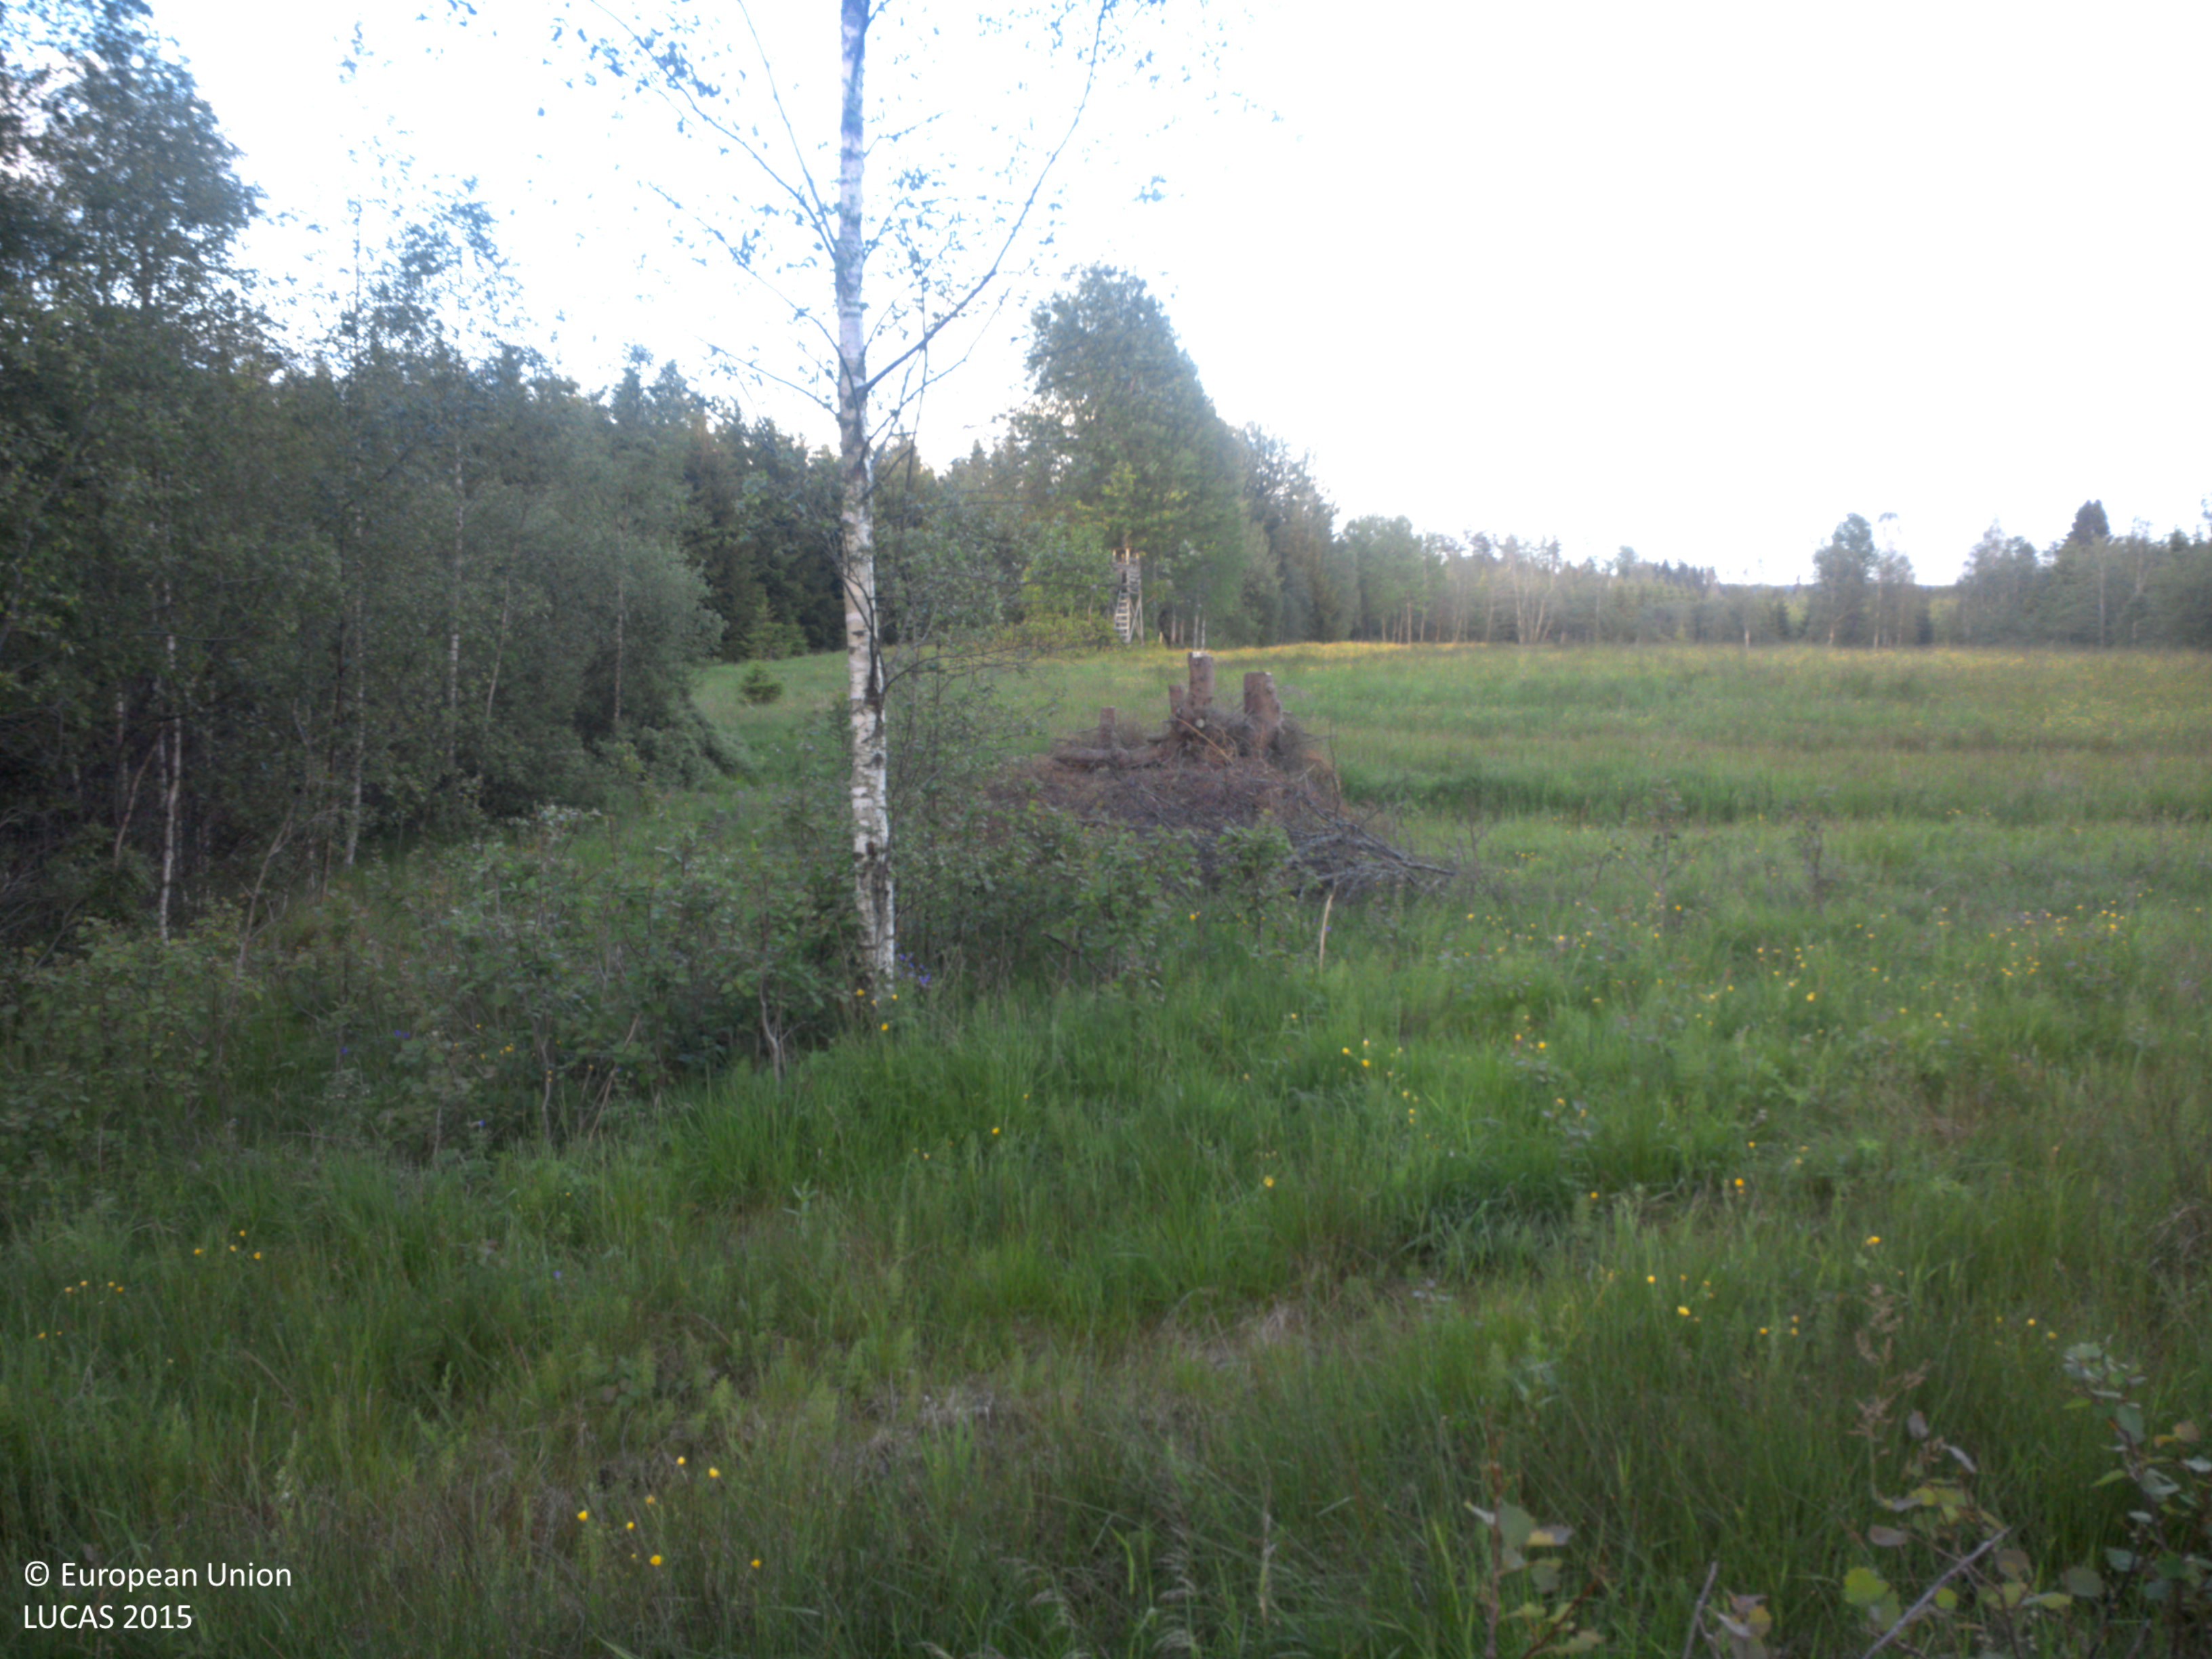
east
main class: Shrubland
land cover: Shrubland with sparse tree cover
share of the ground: > 75 %
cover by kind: shrubs 95 %, broadleaved forest trees 5 %
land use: Residential
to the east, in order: Shrubland with sparse tree cover; Tracks; Broadleaved woodland; Tracks; Grassland with sparse tree/shrub cover; Spruce dominated coniferous woodland; Tracks; Spruce dominated coniferous woodland; Broadleaved woodland; Spruce dominated mixed woodland
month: June
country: SE
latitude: 58.8900
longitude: 11.8870
